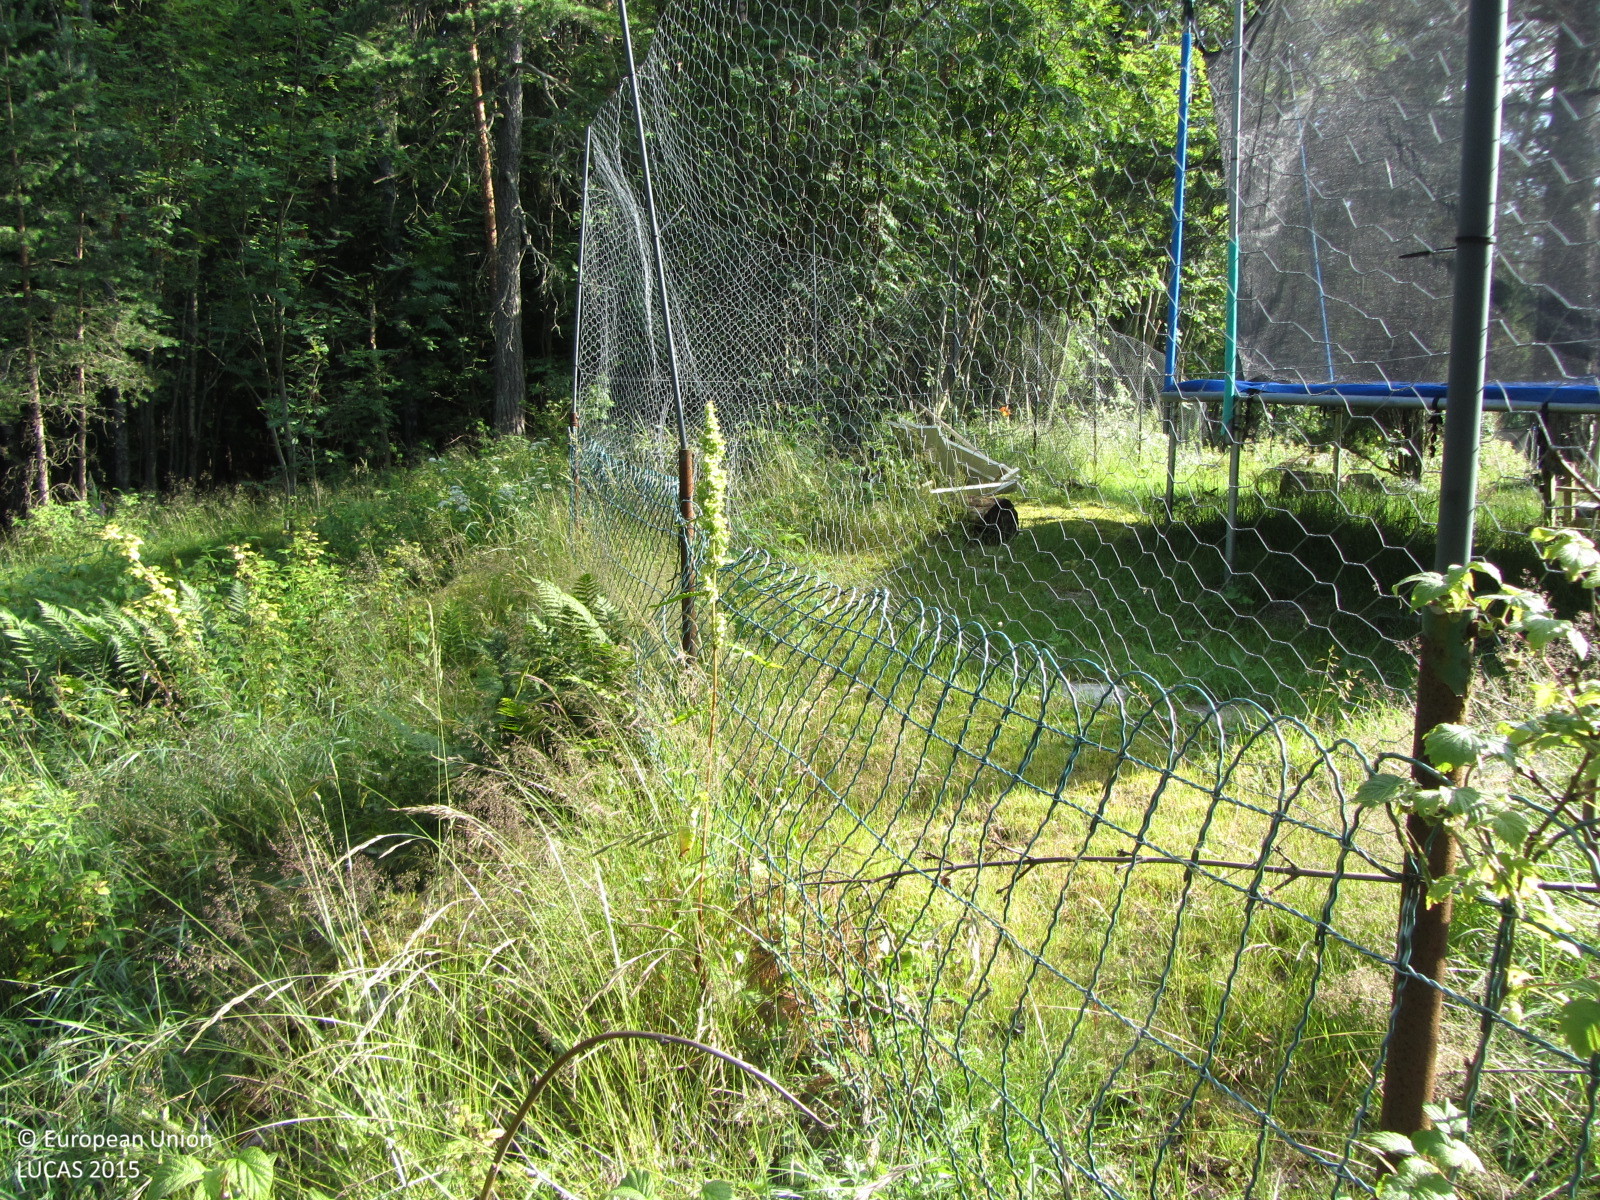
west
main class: Grassland
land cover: Grassland with sparse tree/shrub cover
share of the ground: > 75 %
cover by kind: herbaceous plants 85 %, shrubs 10 %, coniferous forest trees 5 %
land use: Residential
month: July
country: FI
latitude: 60.0963
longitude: 24.4032
